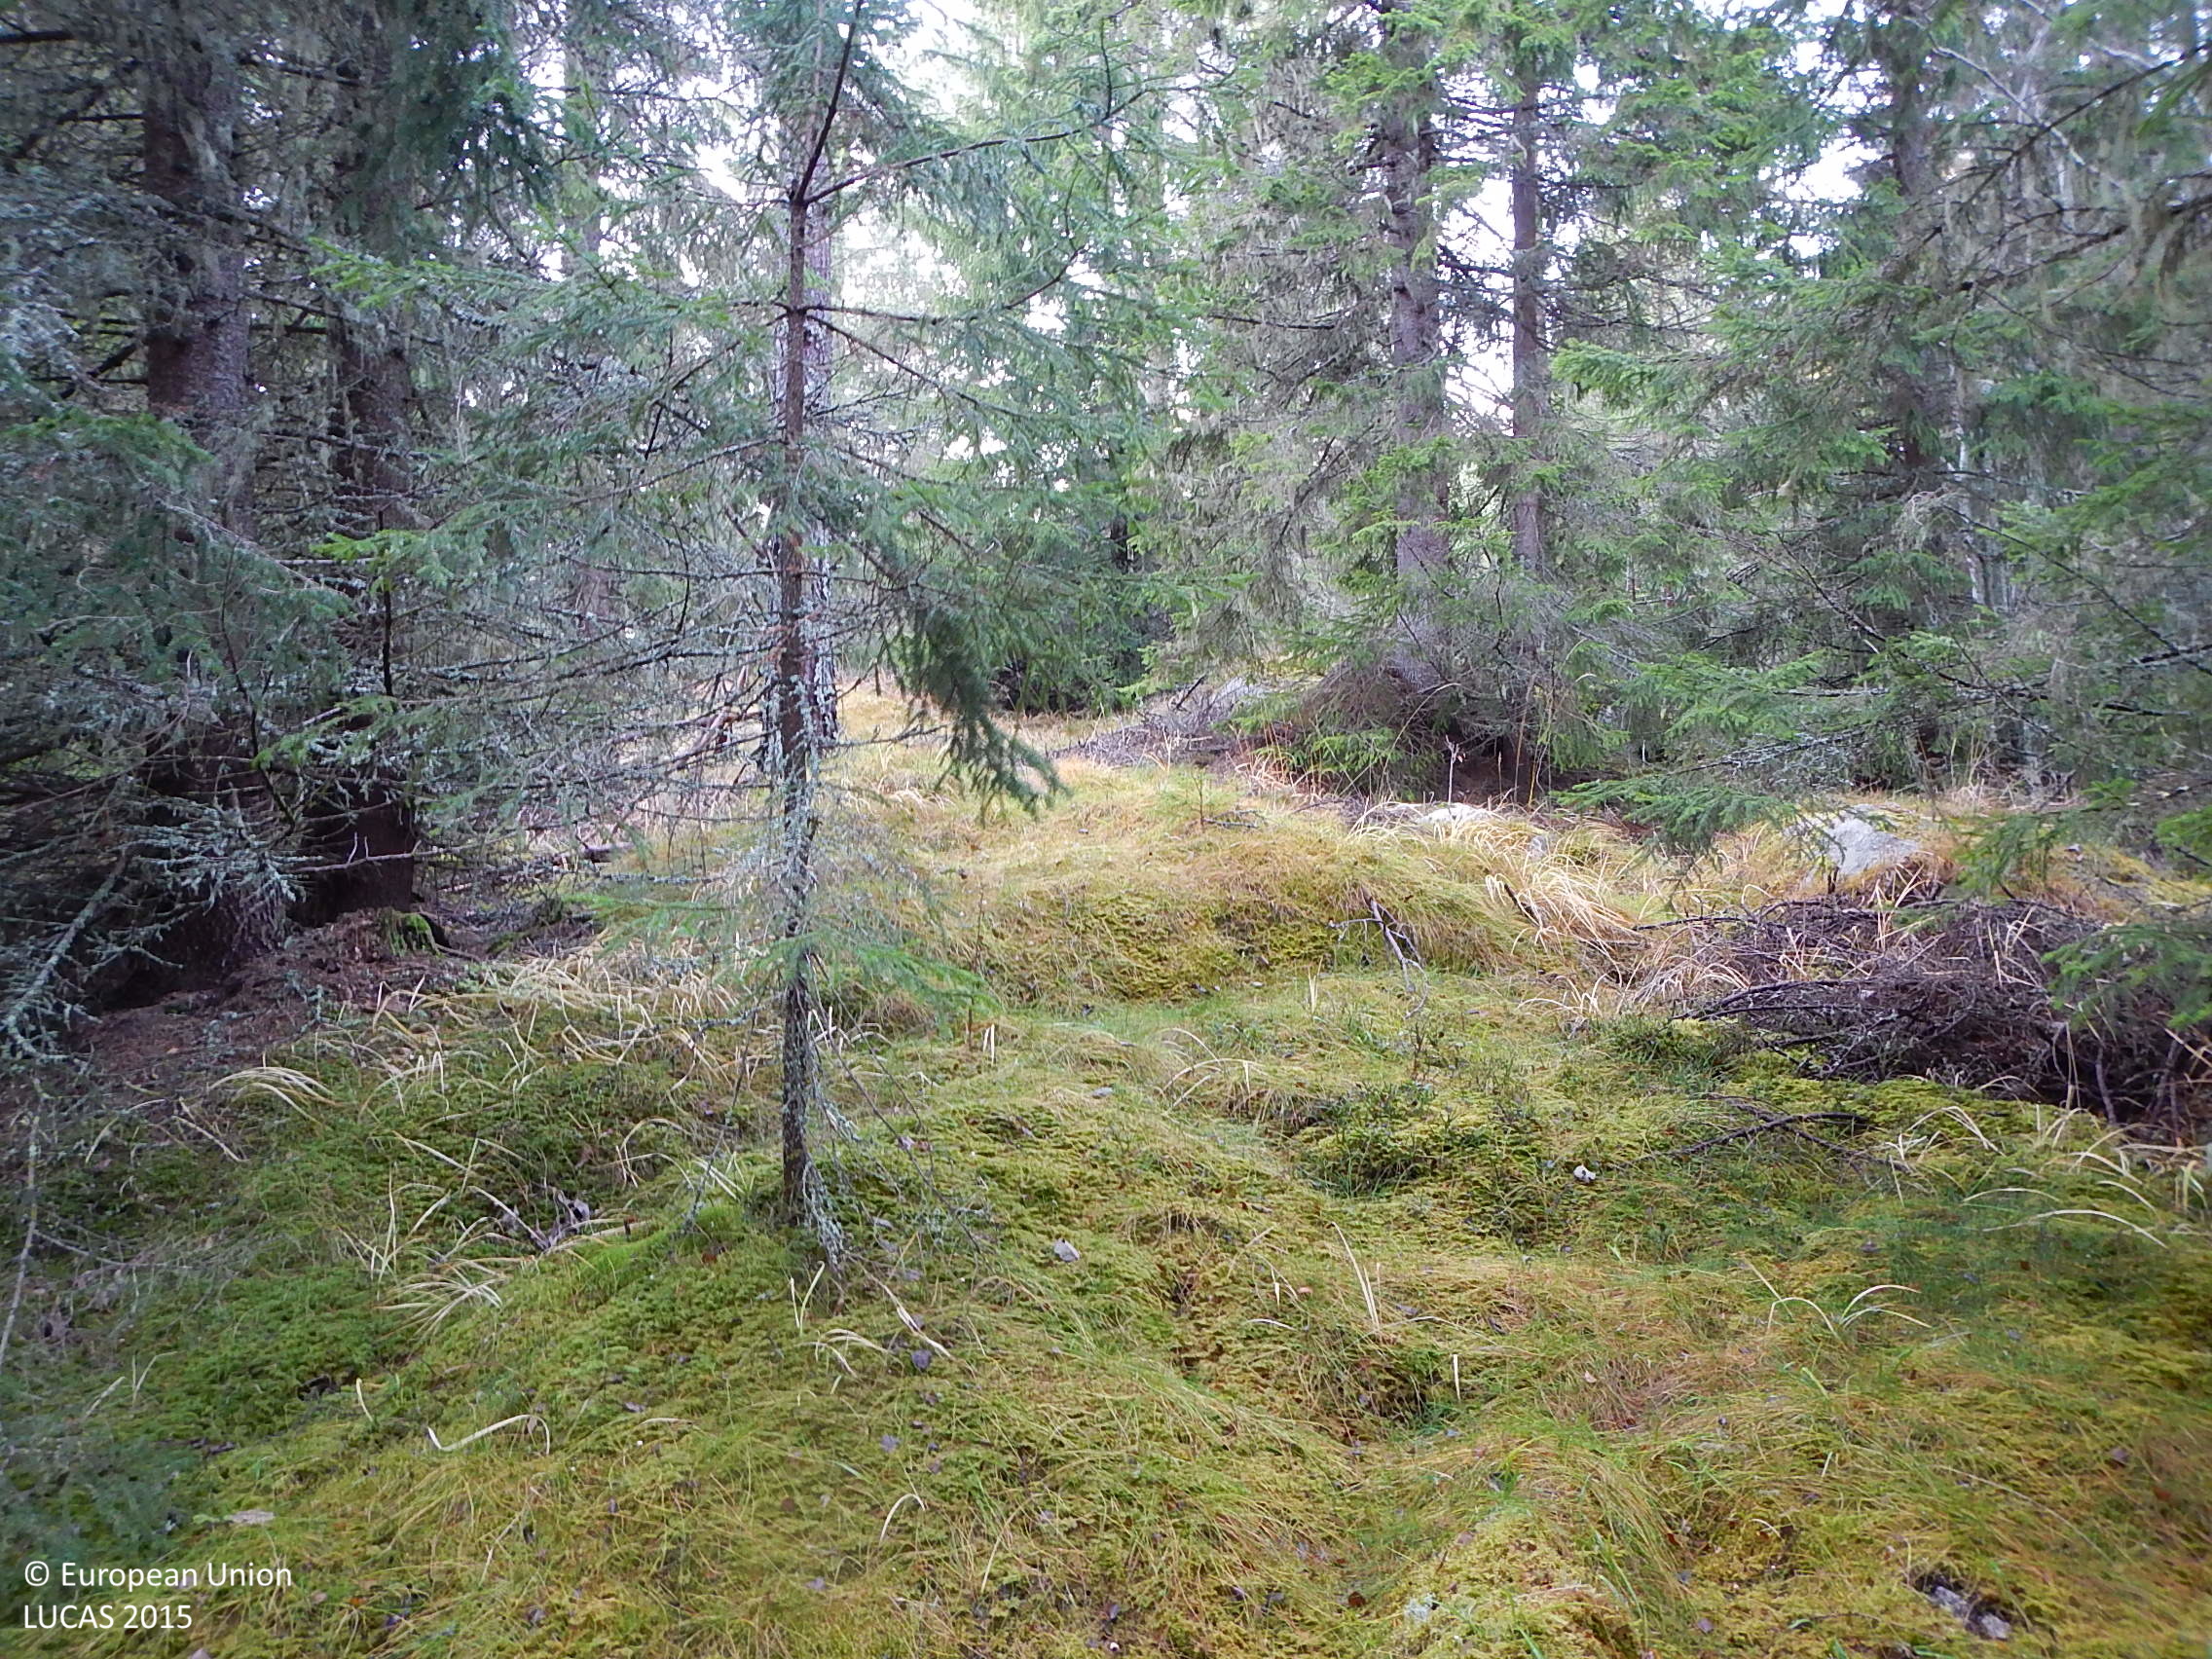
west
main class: Woodland
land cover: Spruce dominated coniferous woodland
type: boreal forest
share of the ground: > 75 %
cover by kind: coniferous forest trees 70 %, lichens and mosses 20 %, broadleaved forest trees 5 %, herbaceous plants 5 %
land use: Forestry
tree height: > 5 m
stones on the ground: < 10 %
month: November
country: SE
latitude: 61.2692
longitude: 15.8592
